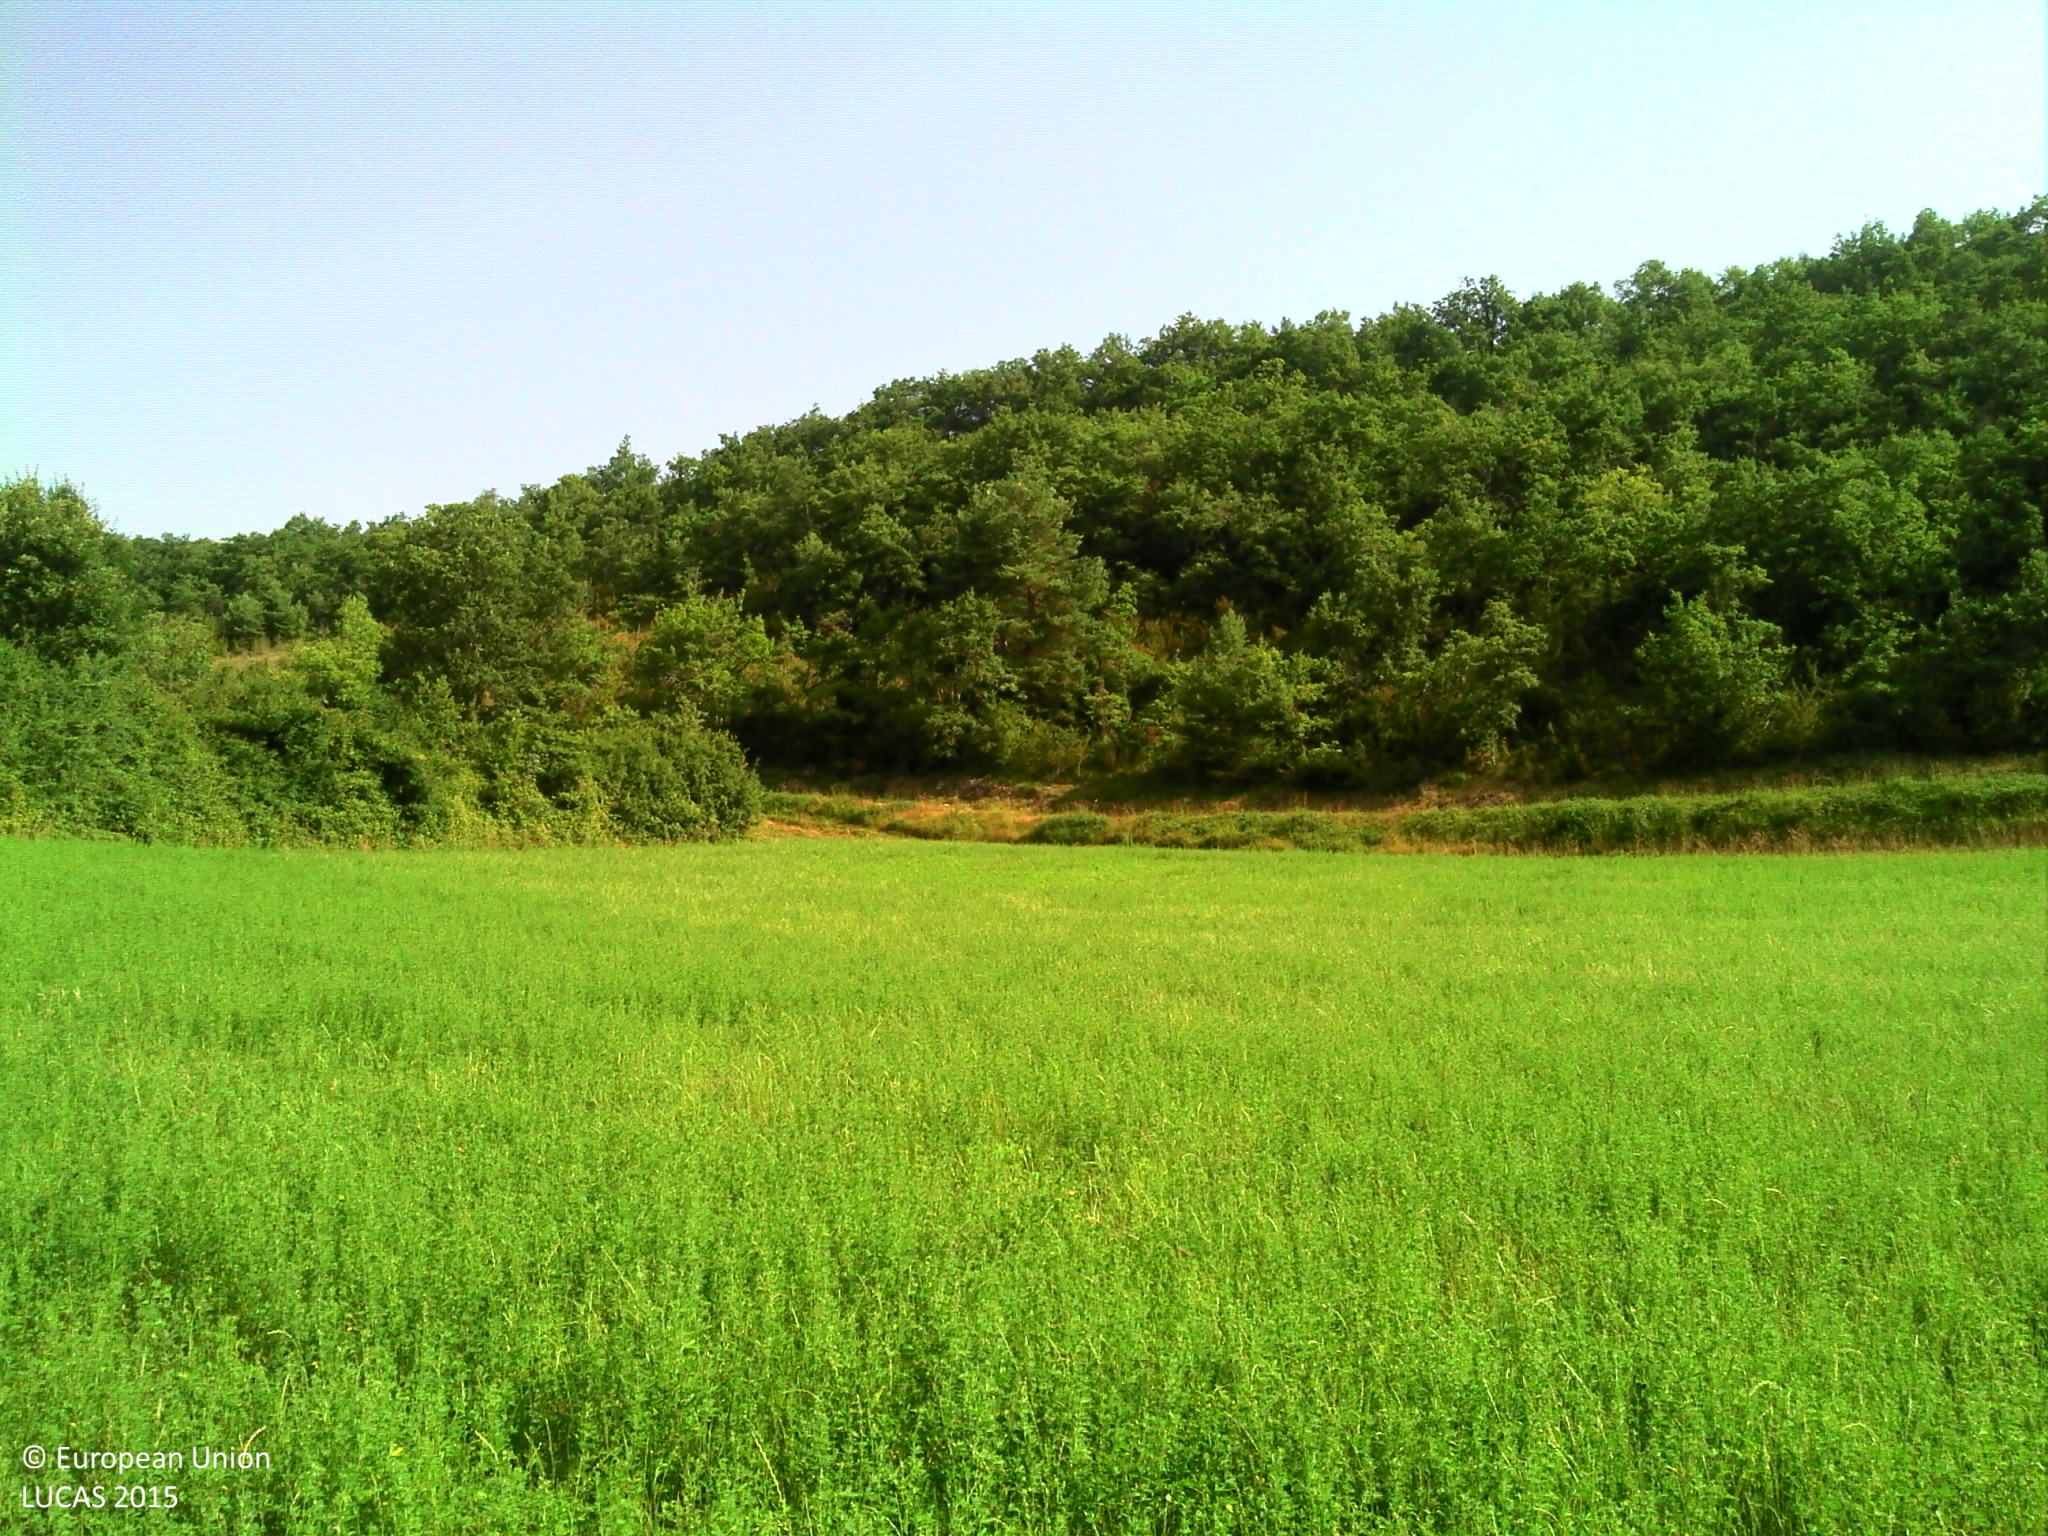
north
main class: Cropland
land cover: Lucerne
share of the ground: > 75 %
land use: Agriculture (excluding fallow land and kitchen gardens)
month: July
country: FR
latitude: 43.1006
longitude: 1.1453
